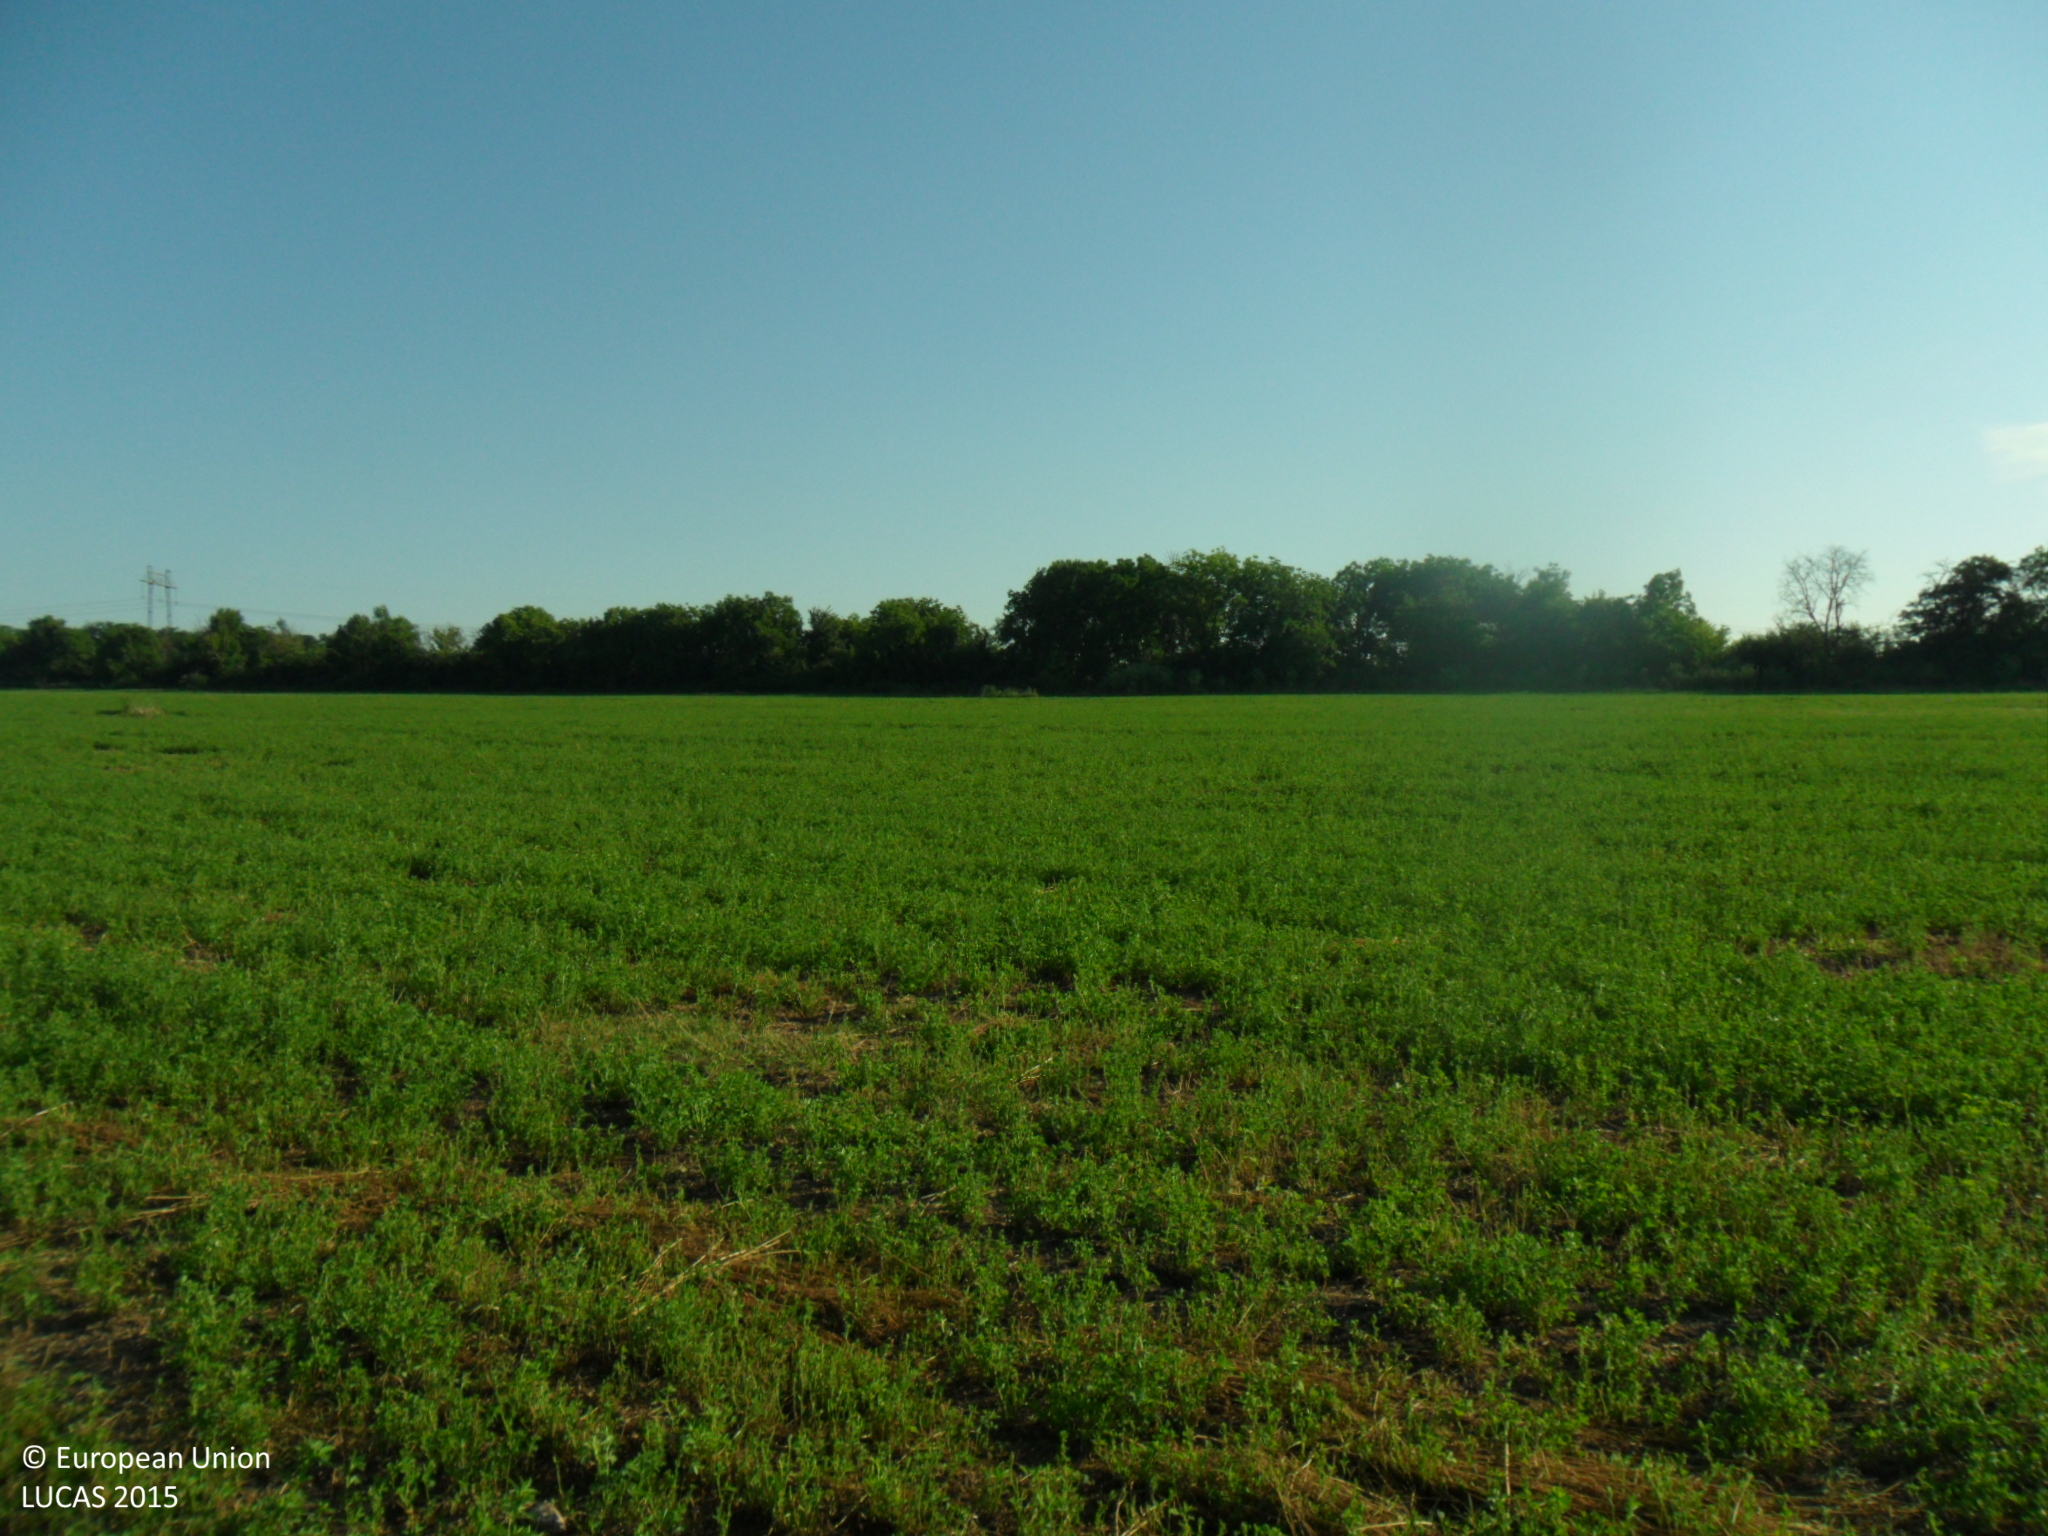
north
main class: Cropland
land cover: Lucerne
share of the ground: > 75 %
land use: Agriculture (excluding fallow land and kitchen gardens)
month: June
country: BG
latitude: 43.3141
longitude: 27.0450
